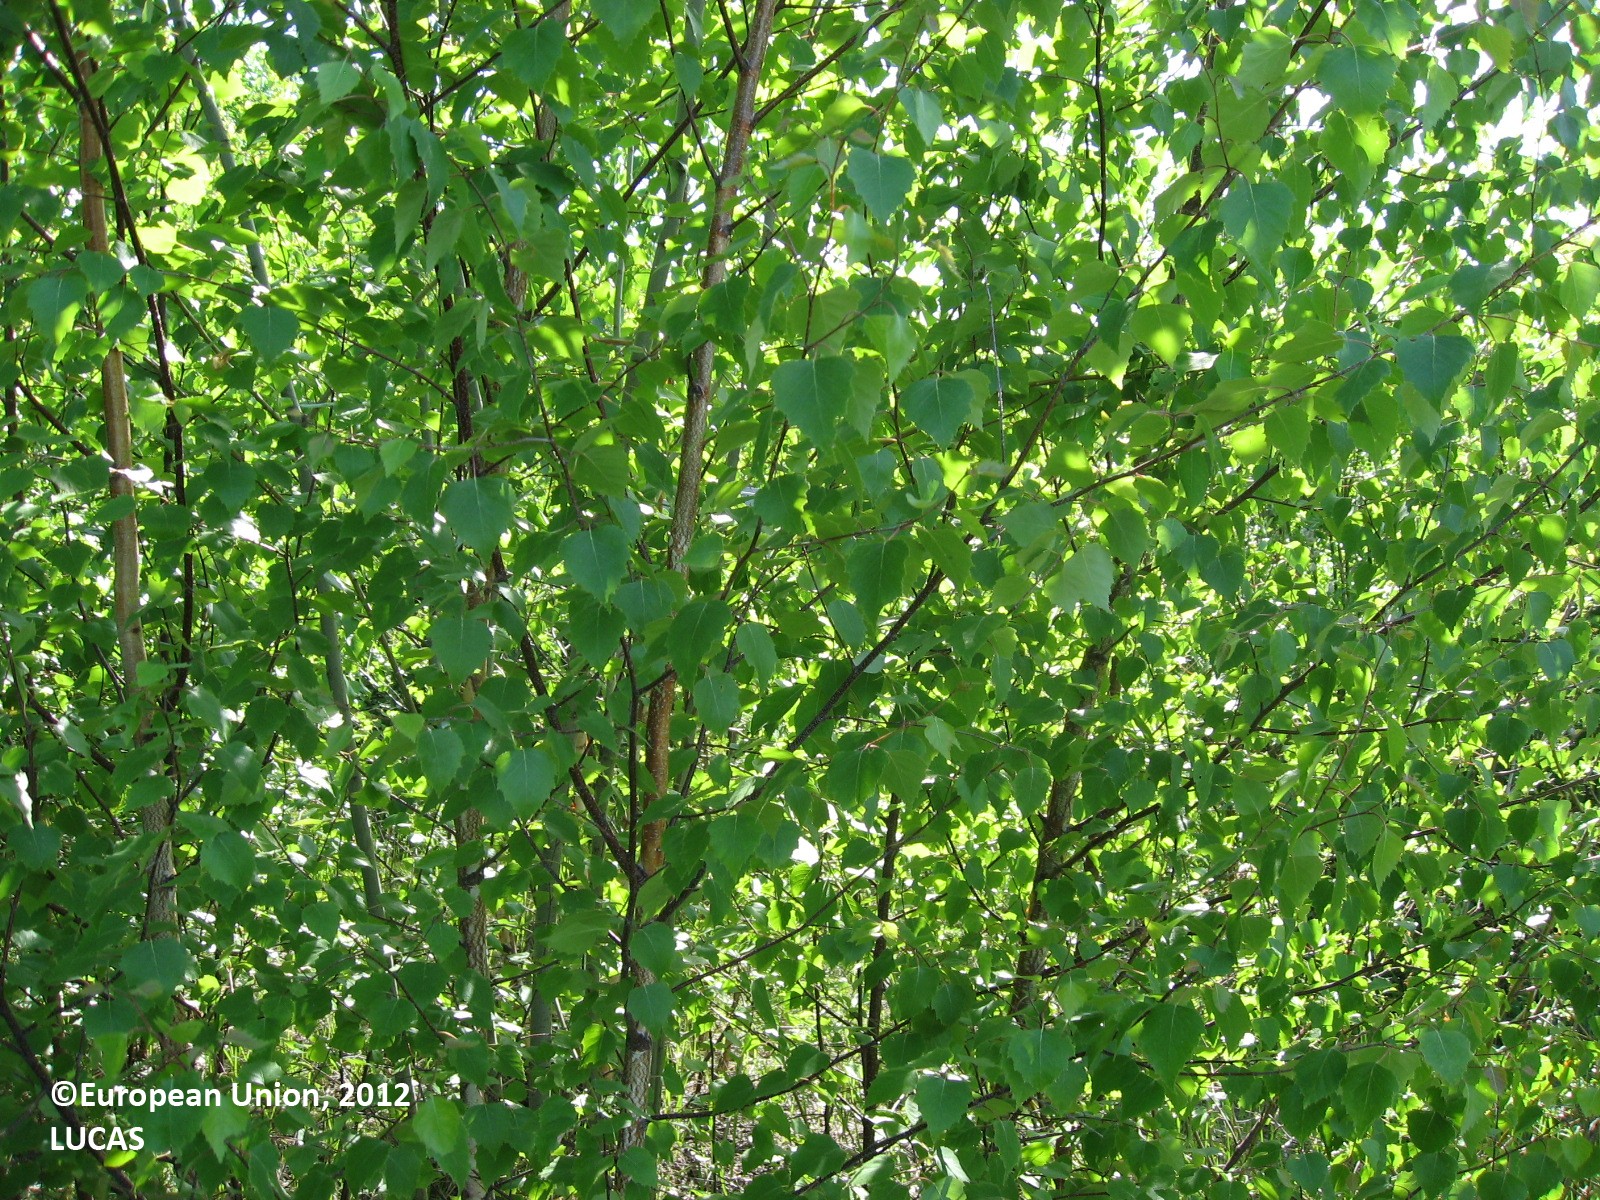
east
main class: Woodland
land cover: Broadleaved woodland
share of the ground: 50 - 75 %
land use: Water transport
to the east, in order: Broadleaved woodland; Artificial constructions in urban areas
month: June
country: FI
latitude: 60.4086
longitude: 26.2528
